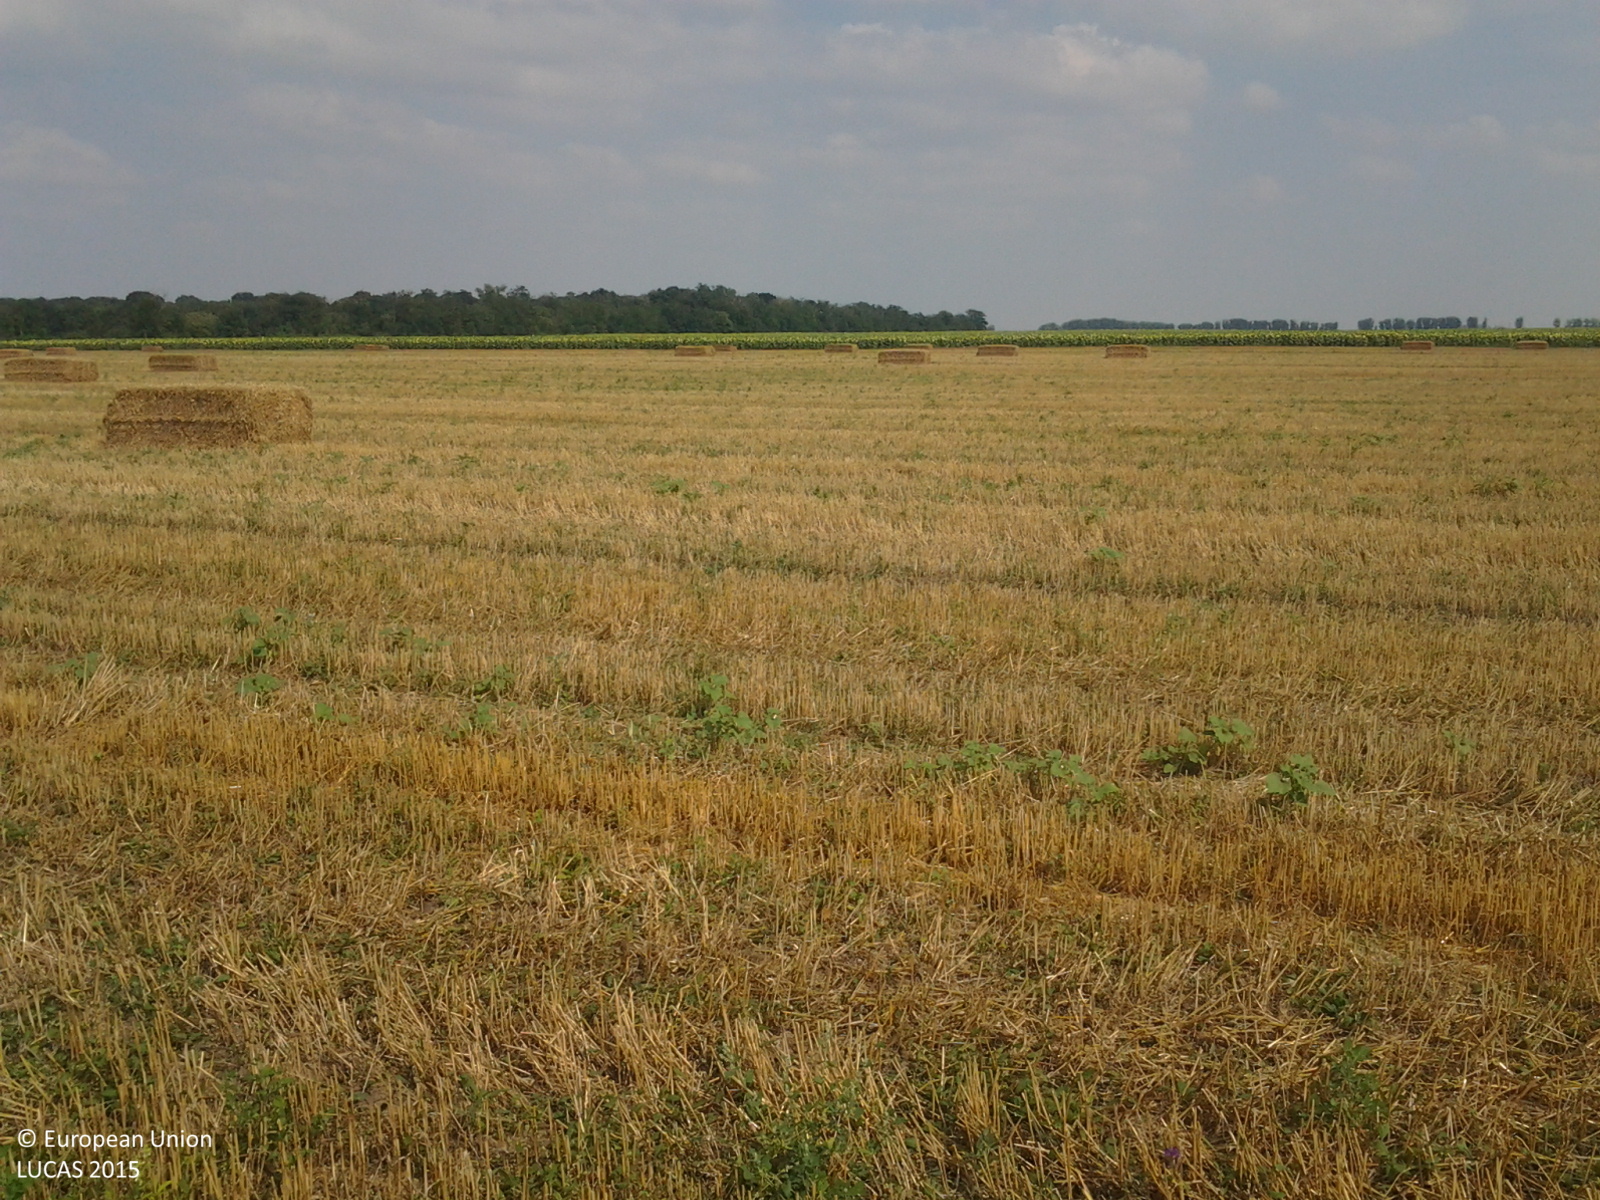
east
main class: Cropland
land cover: Common wheat
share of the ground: 10 - 25 %
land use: Agriculture (excluding fallow land and kitchen gardens)
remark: Harvested field
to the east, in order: Common wheat; Sunflower
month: August
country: HU
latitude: 47.0472
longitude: 20.3337
